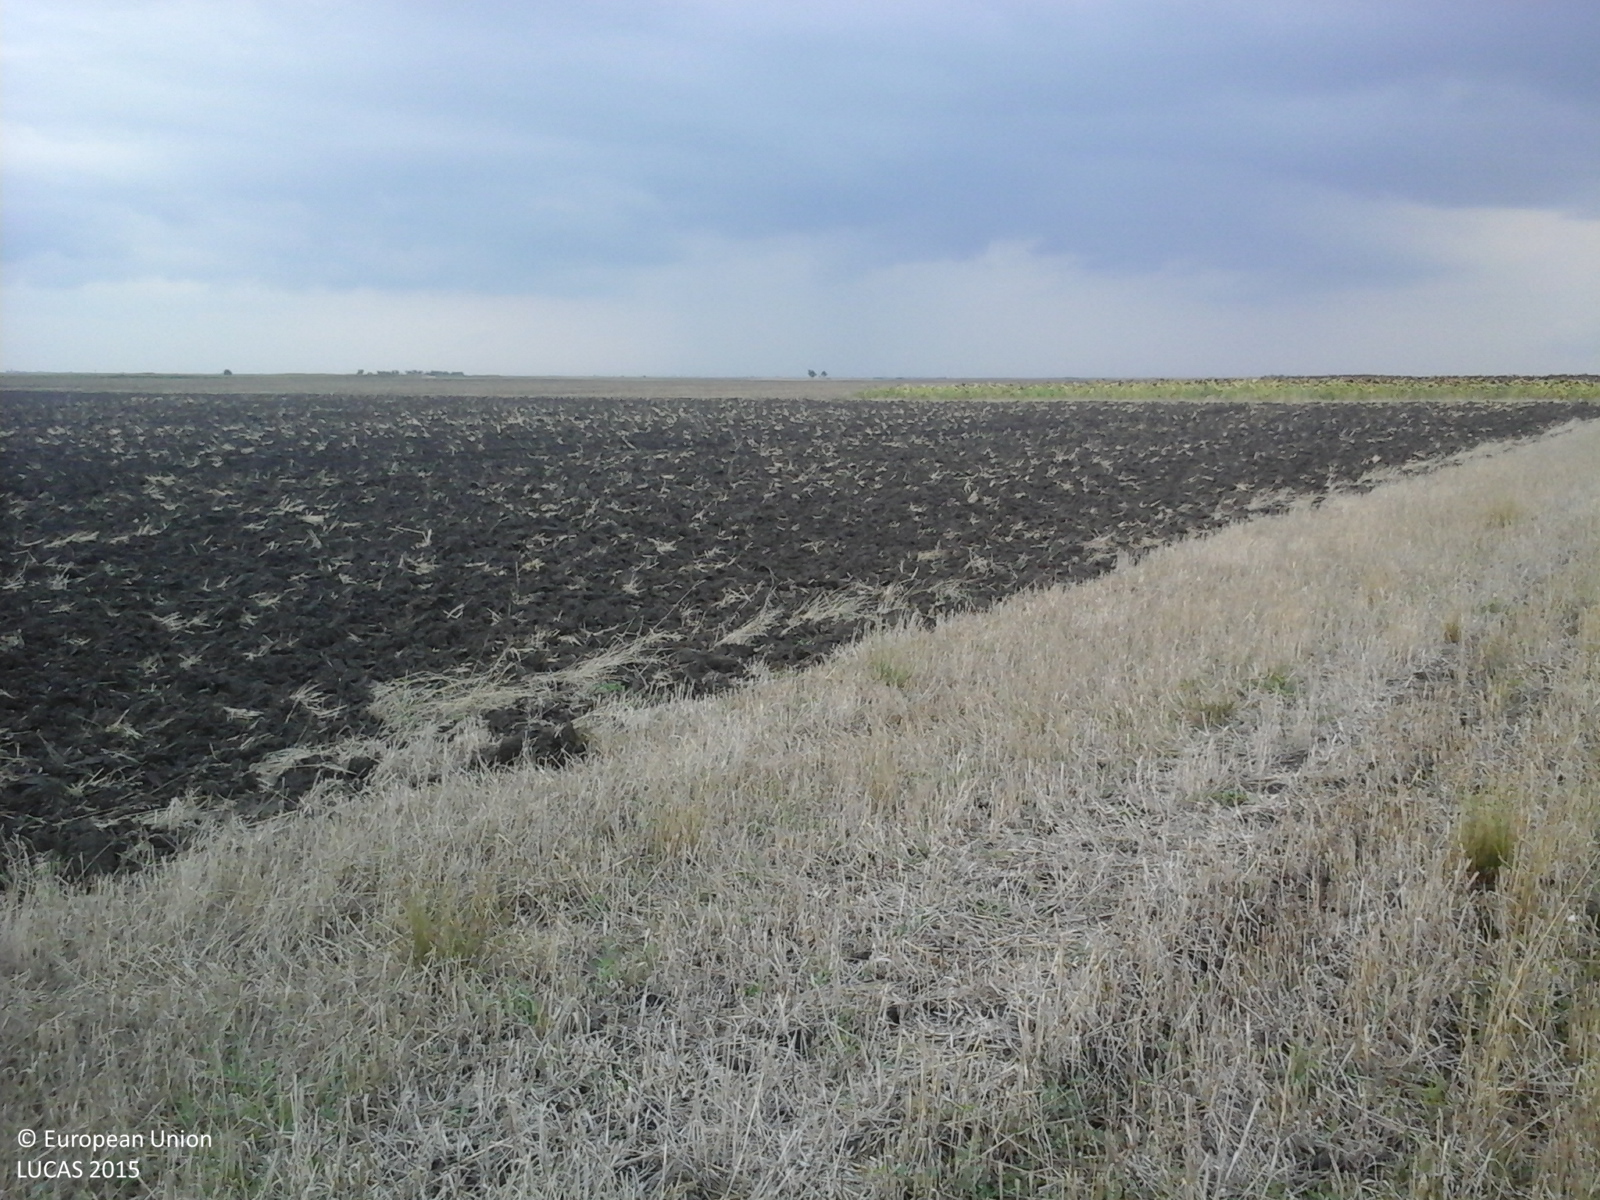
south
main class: Cropland
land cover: Durum wheat
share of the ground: 25 - 50 %
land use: Agriculture (excluding fallow land and kitchen gardens)
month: August
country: RO
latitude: 46.0325
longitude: 20.5024
